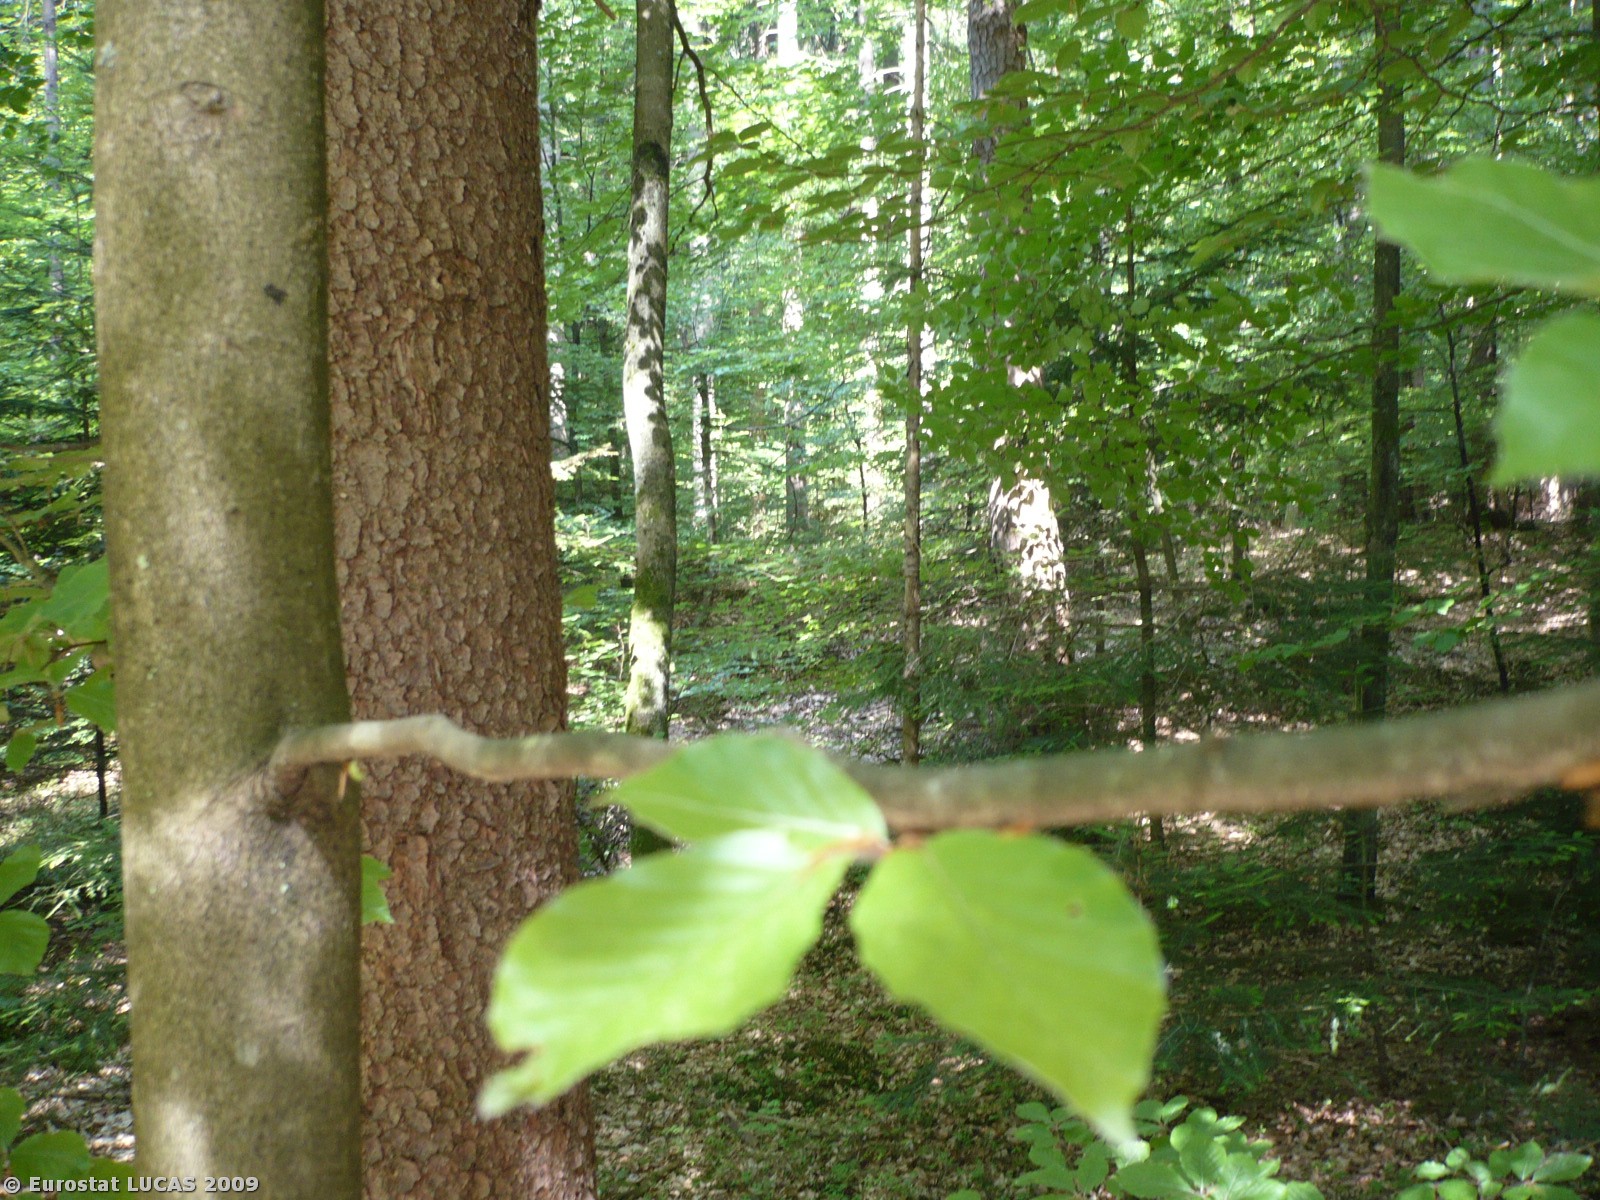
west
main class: Woodland
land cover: Mixed woodland
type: hemiboreal forest and nemoral coniferous forest and mixed broadleaved-coniferous forest
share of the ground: > 75 %
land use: Forestry
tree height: > 5 m
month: May
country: SI
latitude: 46.2852
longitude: 14.2410
